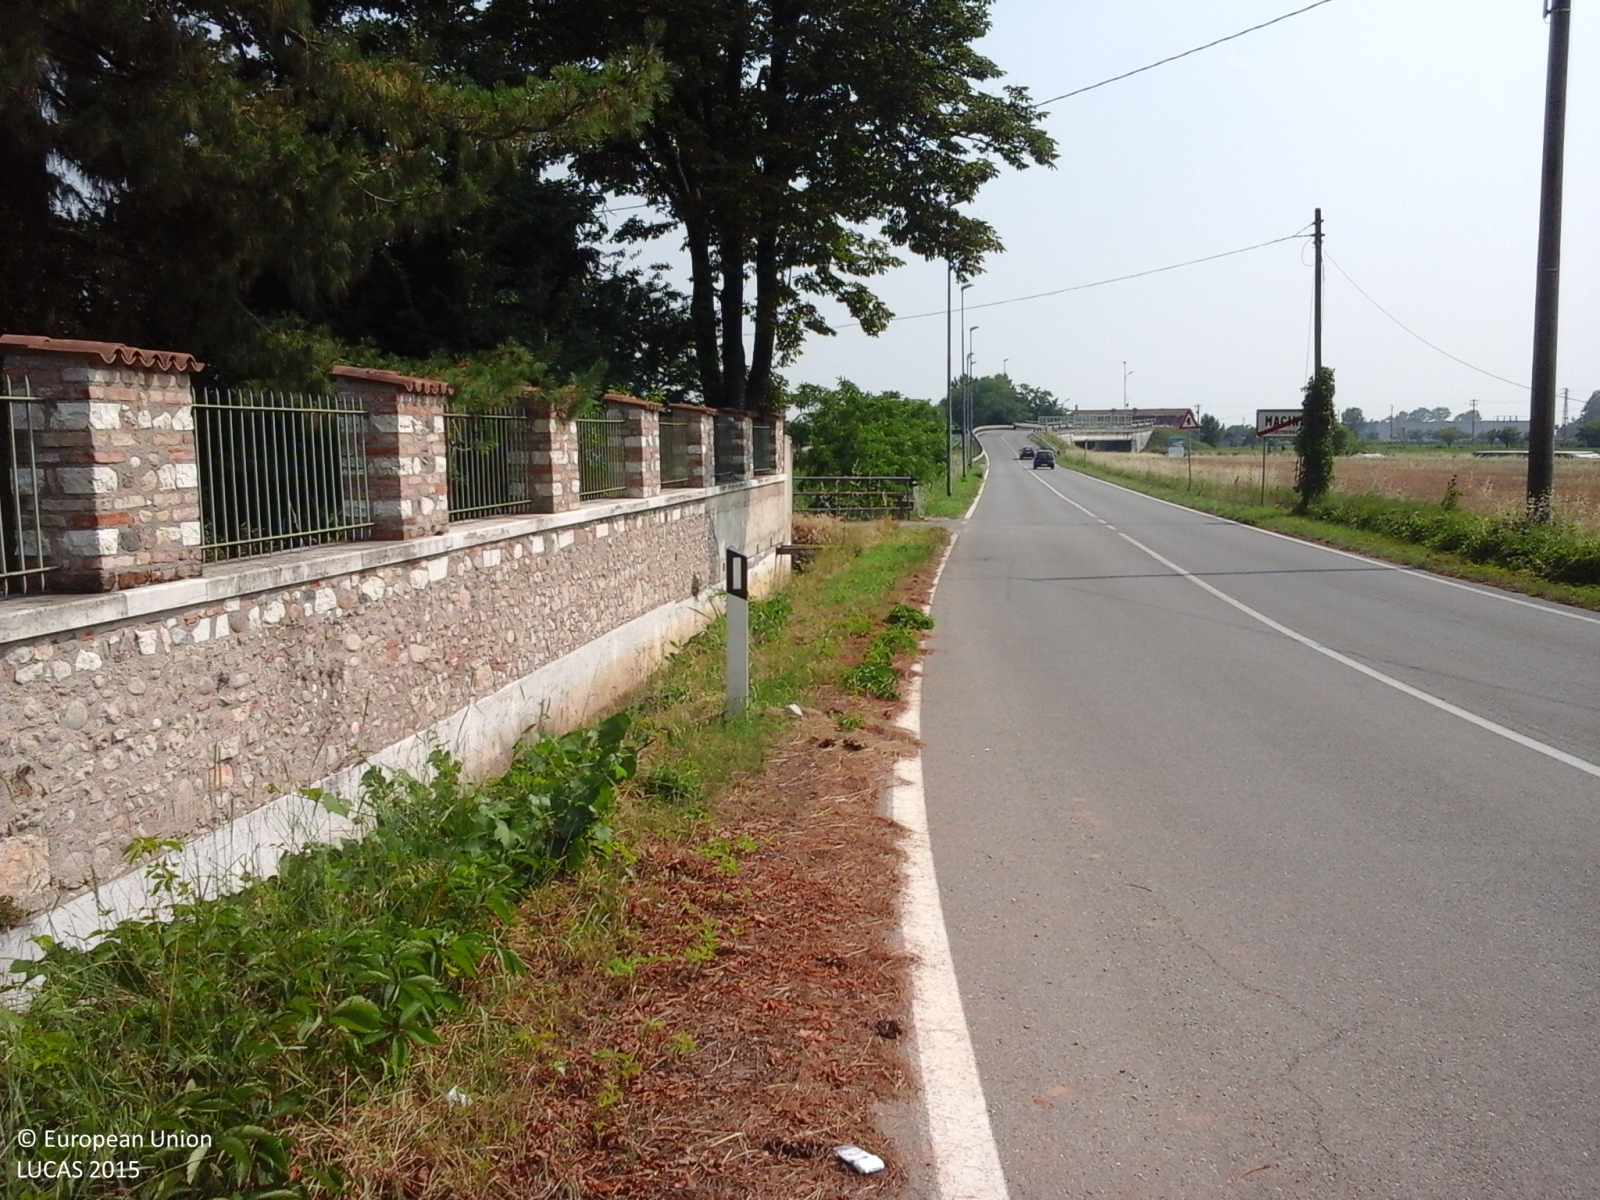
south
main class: Woodland
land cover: Broadleaved woodland
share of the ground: > 75 %
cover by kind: herbaceous plants 80 %, broadleaved forest trees 20 %
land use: Residential
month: June
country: IT
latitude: 45.4679
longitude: 10.3192
